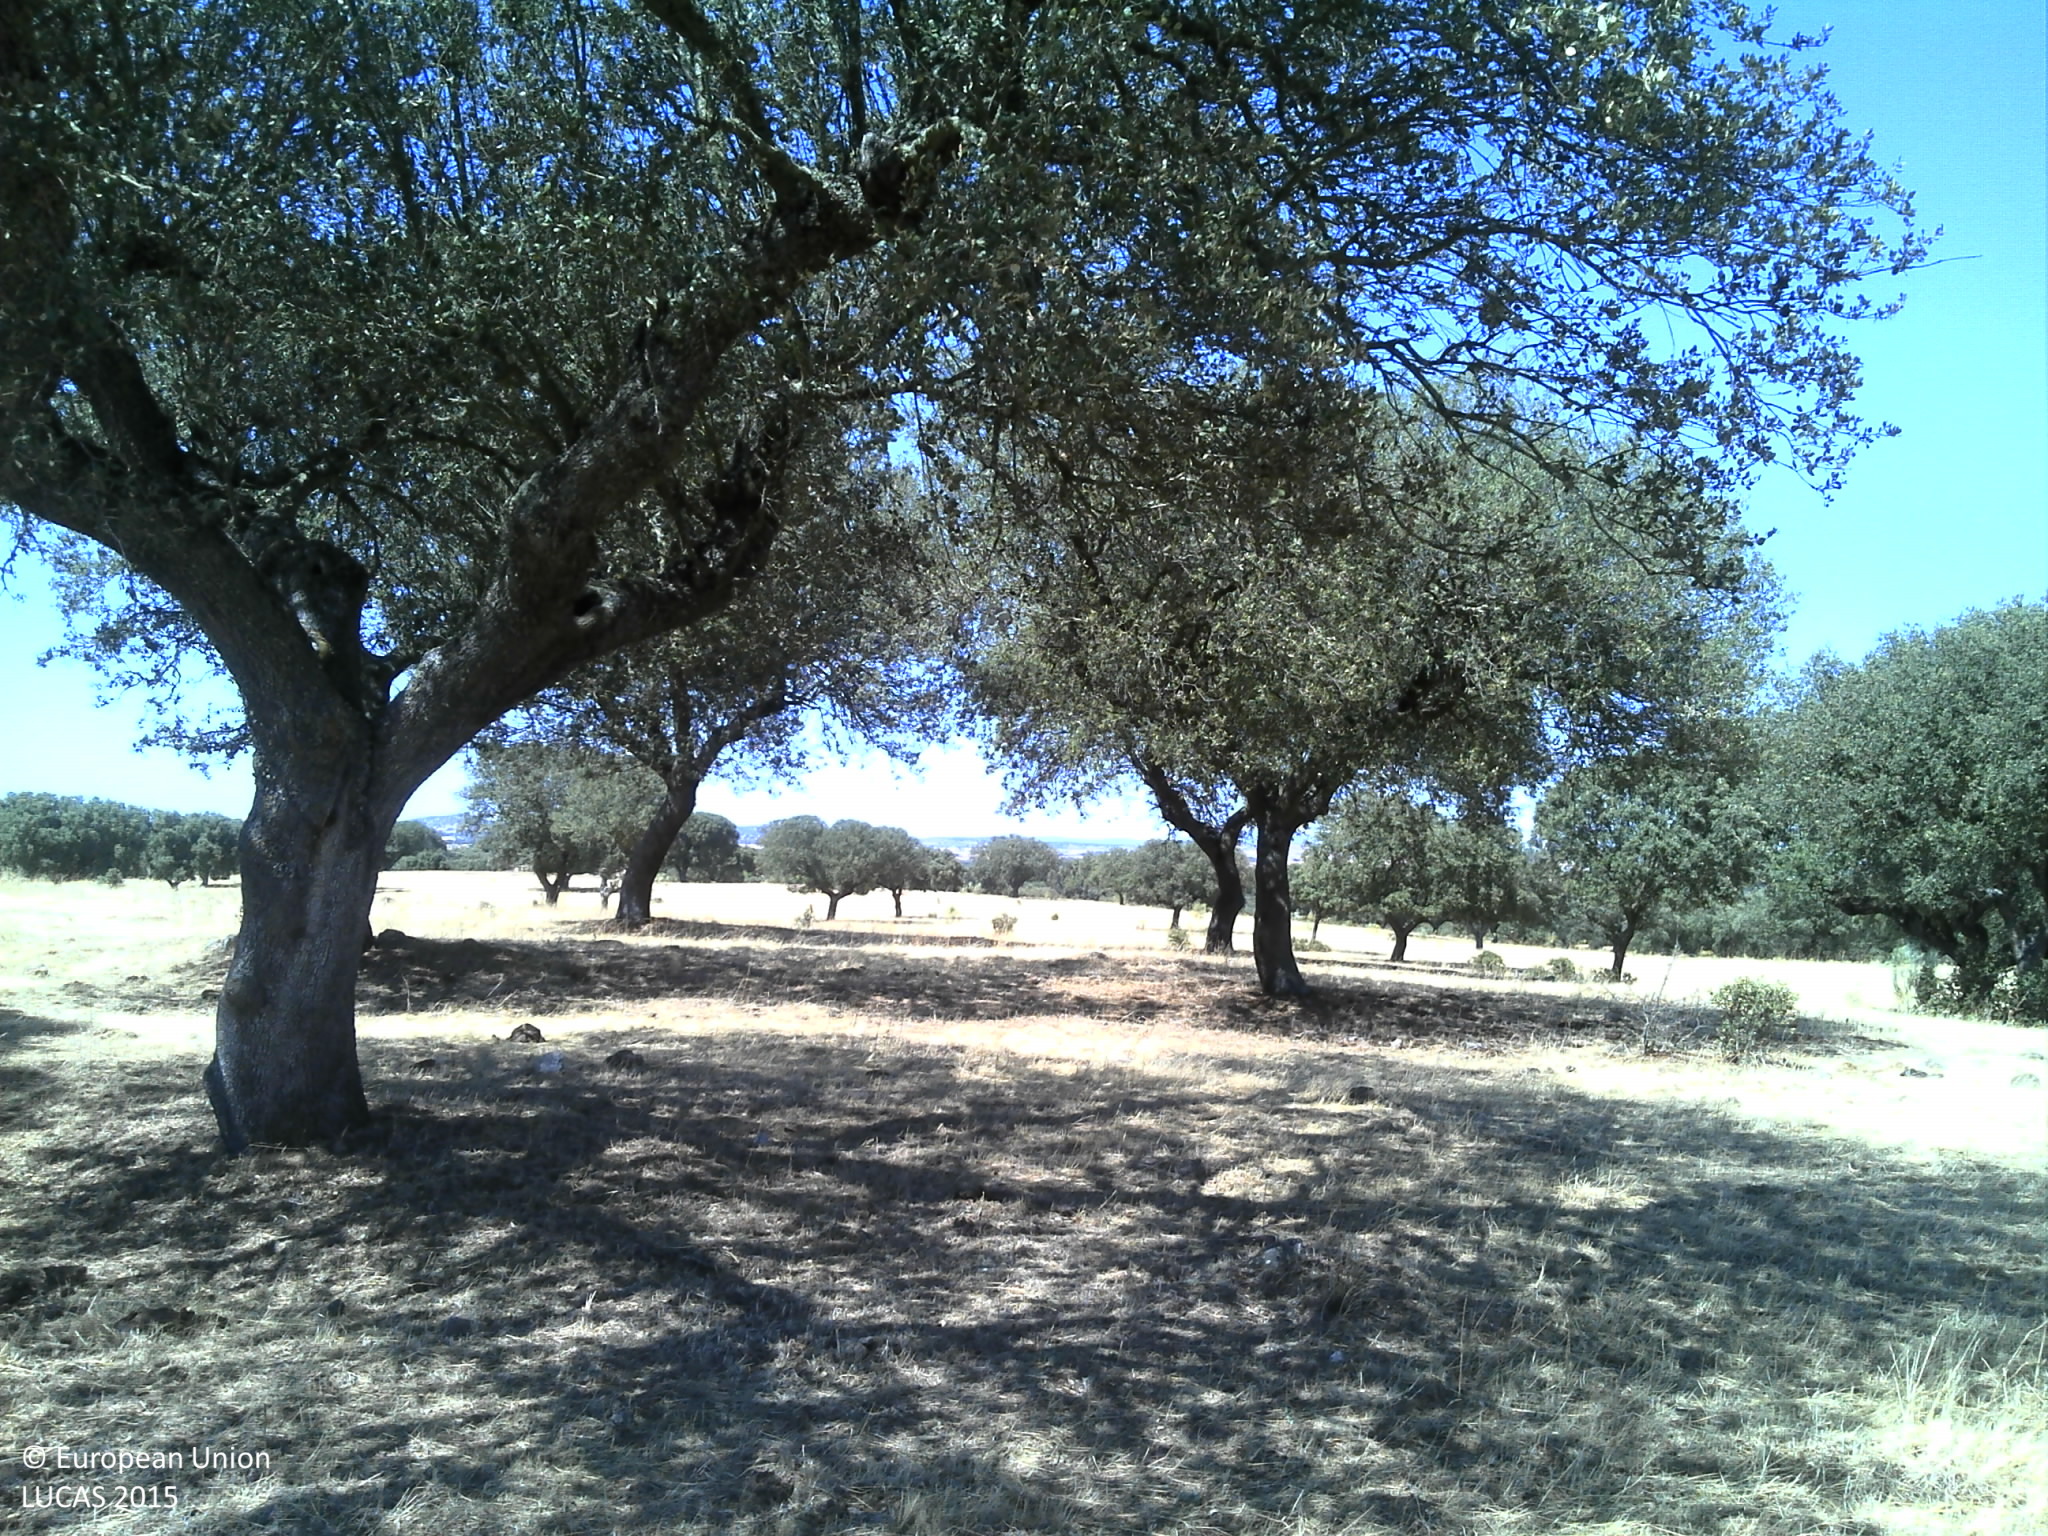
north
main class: Woodland
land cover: Broadleaved woodland
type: broadleaved evergreen forest
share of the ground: 25 - 50 %
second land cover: Grassland without tree/shrub cover
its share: 10 - 25 %
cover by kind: unconsolidated bare surface 55 %, broadleaved forest trees 25 %, herbaceous plants 20 %
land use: Forestry
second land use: Agriculture (excluding fallow land and kitchen gardens)
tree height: > 5 m
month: July
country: PT
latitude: 39.0243
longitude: -7.5384
